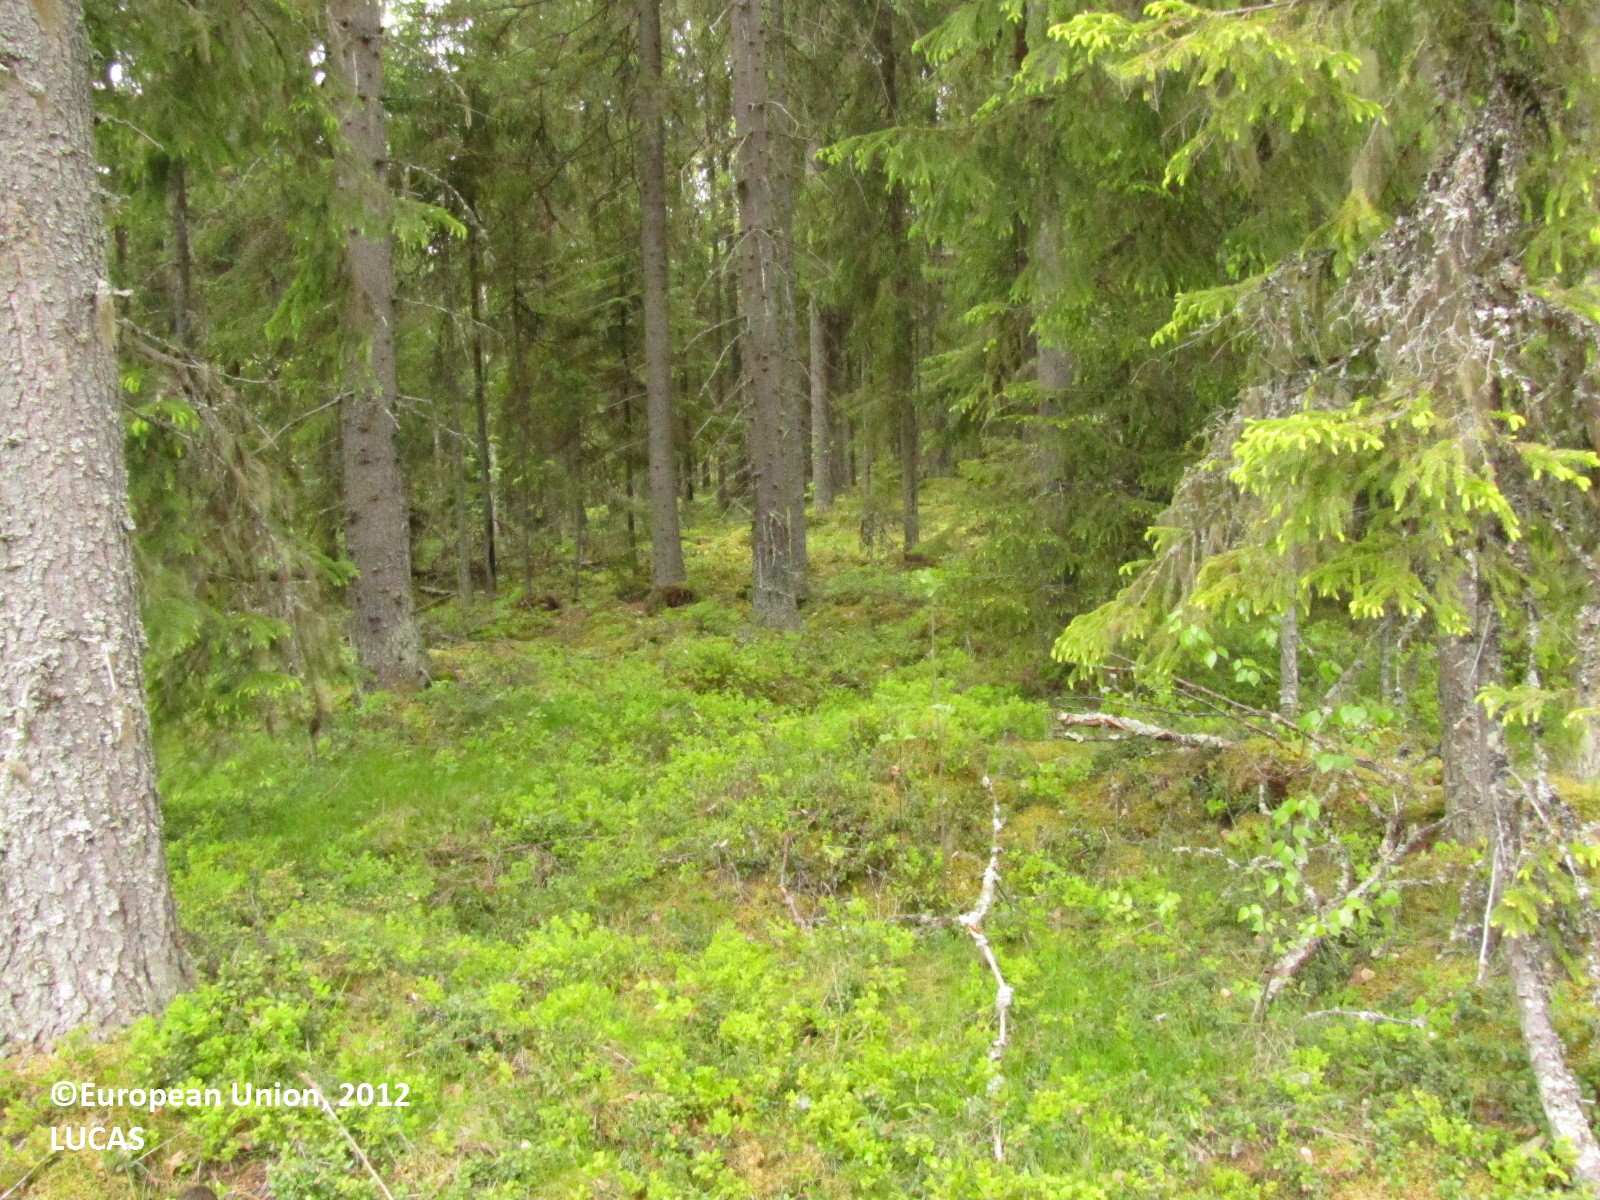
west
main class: Woodland
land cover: Spruce dominated mixed woodland
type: boreal forest
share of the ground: > 75 %
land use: Forestry
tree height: < 5 m
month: June
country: FI
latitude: 61.6398
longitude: 23.0352
